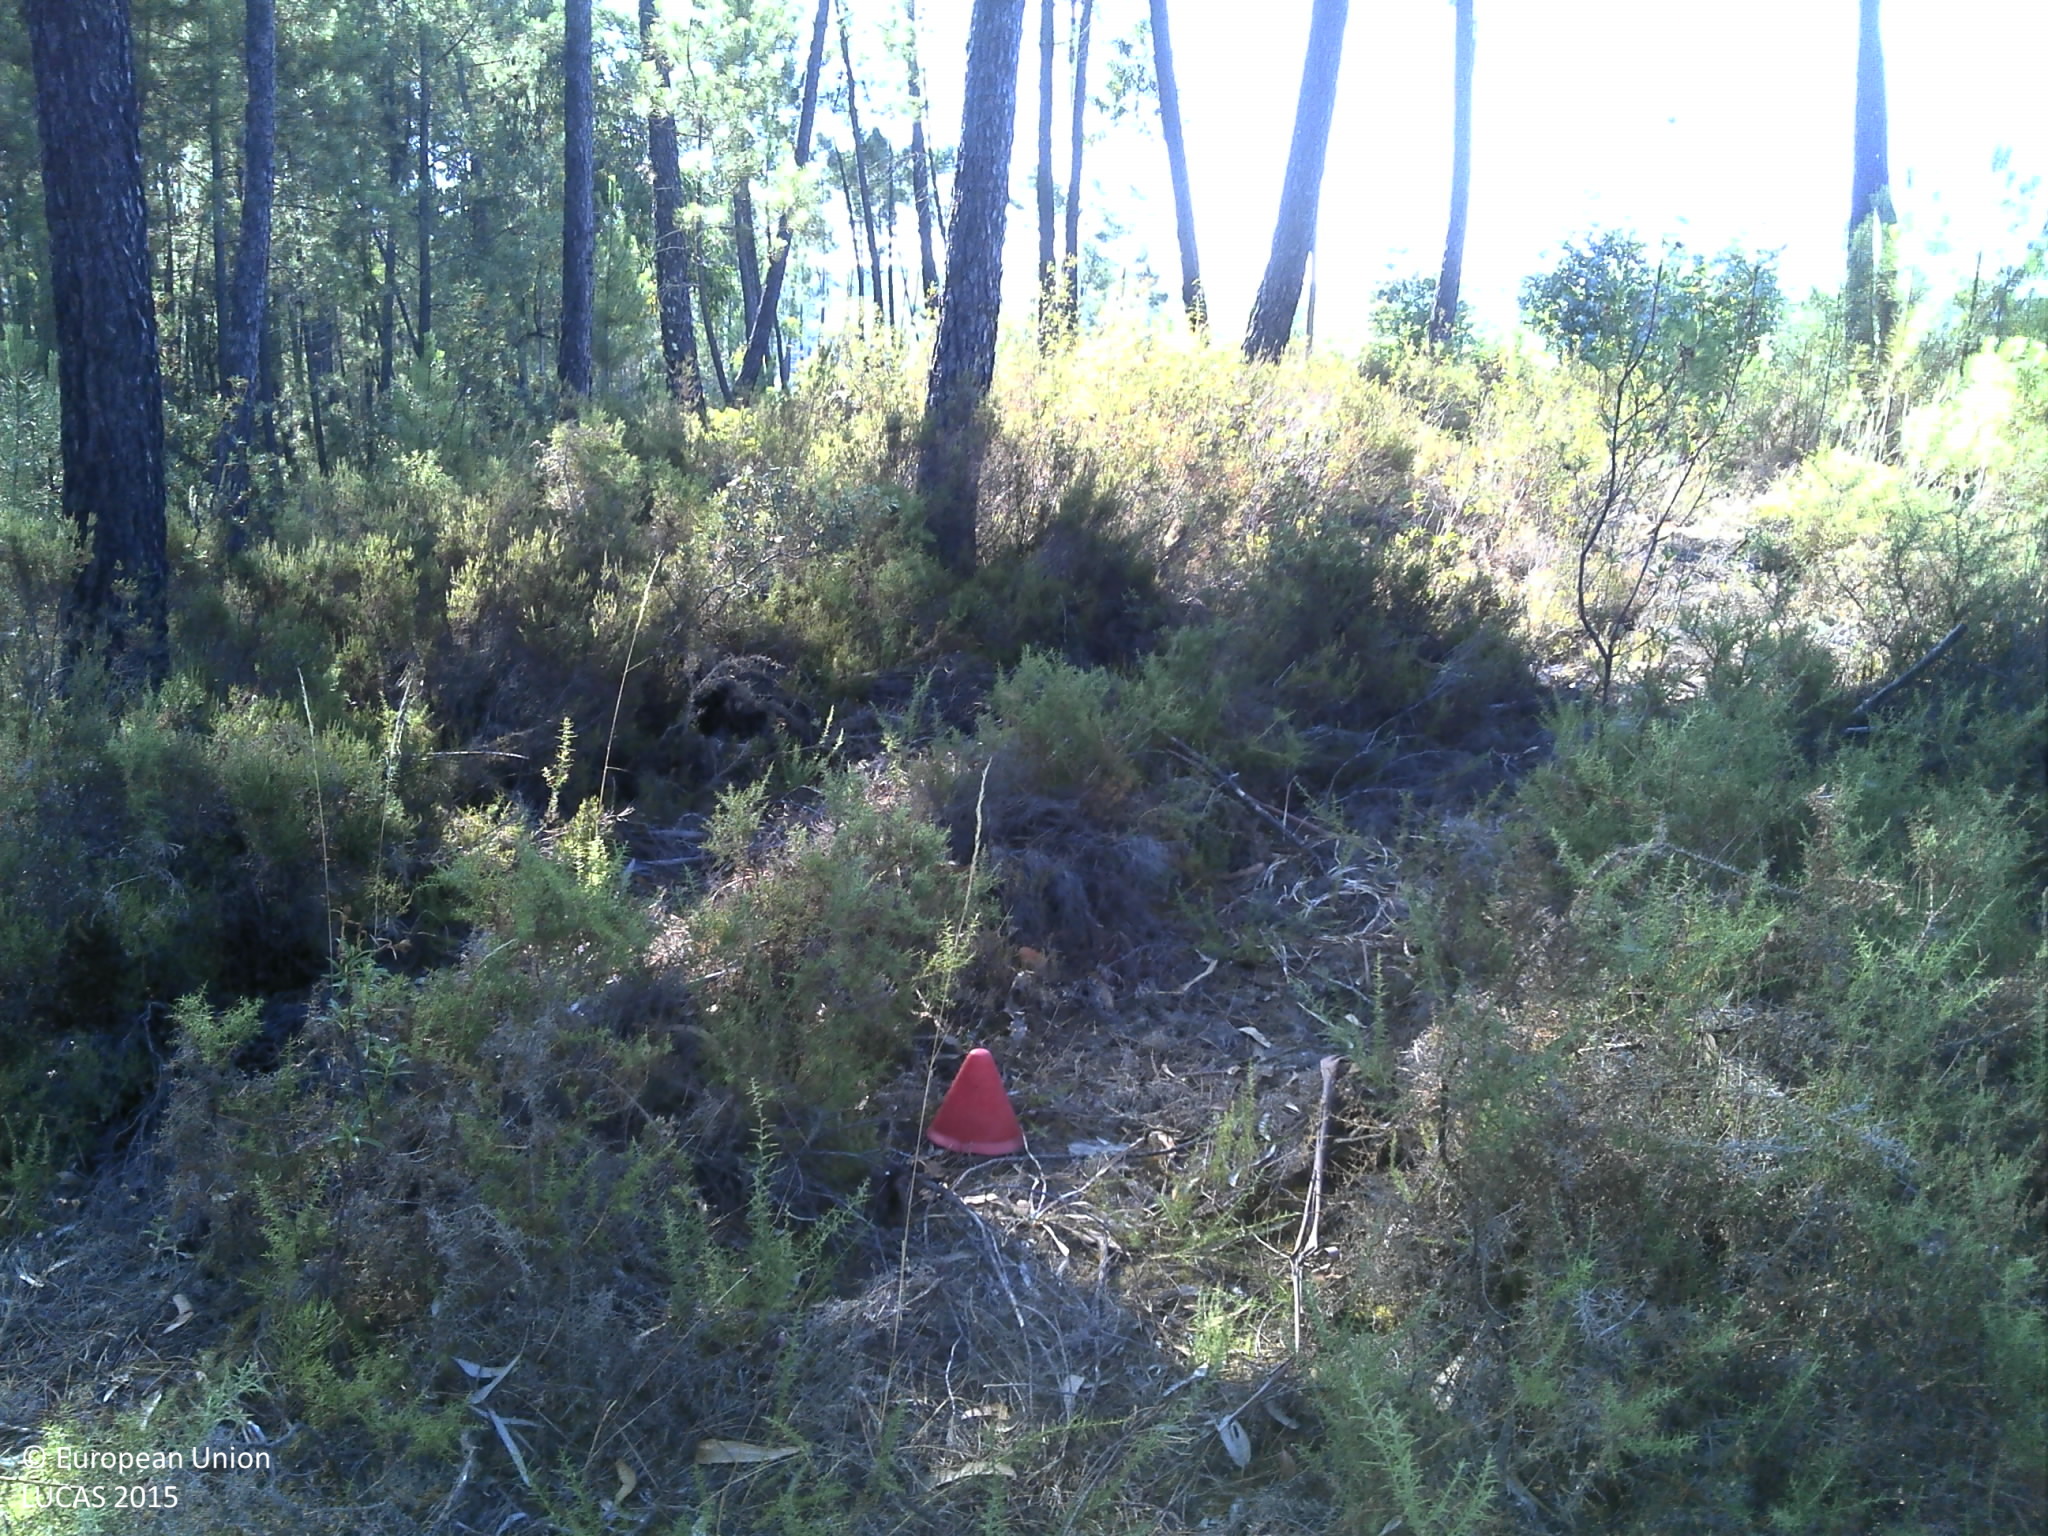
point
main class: Woodland
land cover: Pine dominated coniferous woodland
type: coniferous forest of the mediterranean region
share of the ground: 10 - 25 %
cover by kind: shrubs 70 %, coniferous forest trees 30 %
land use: Forestry
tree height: > 5 m
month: July
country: PT
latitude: 39.7731
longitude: -8.0804
